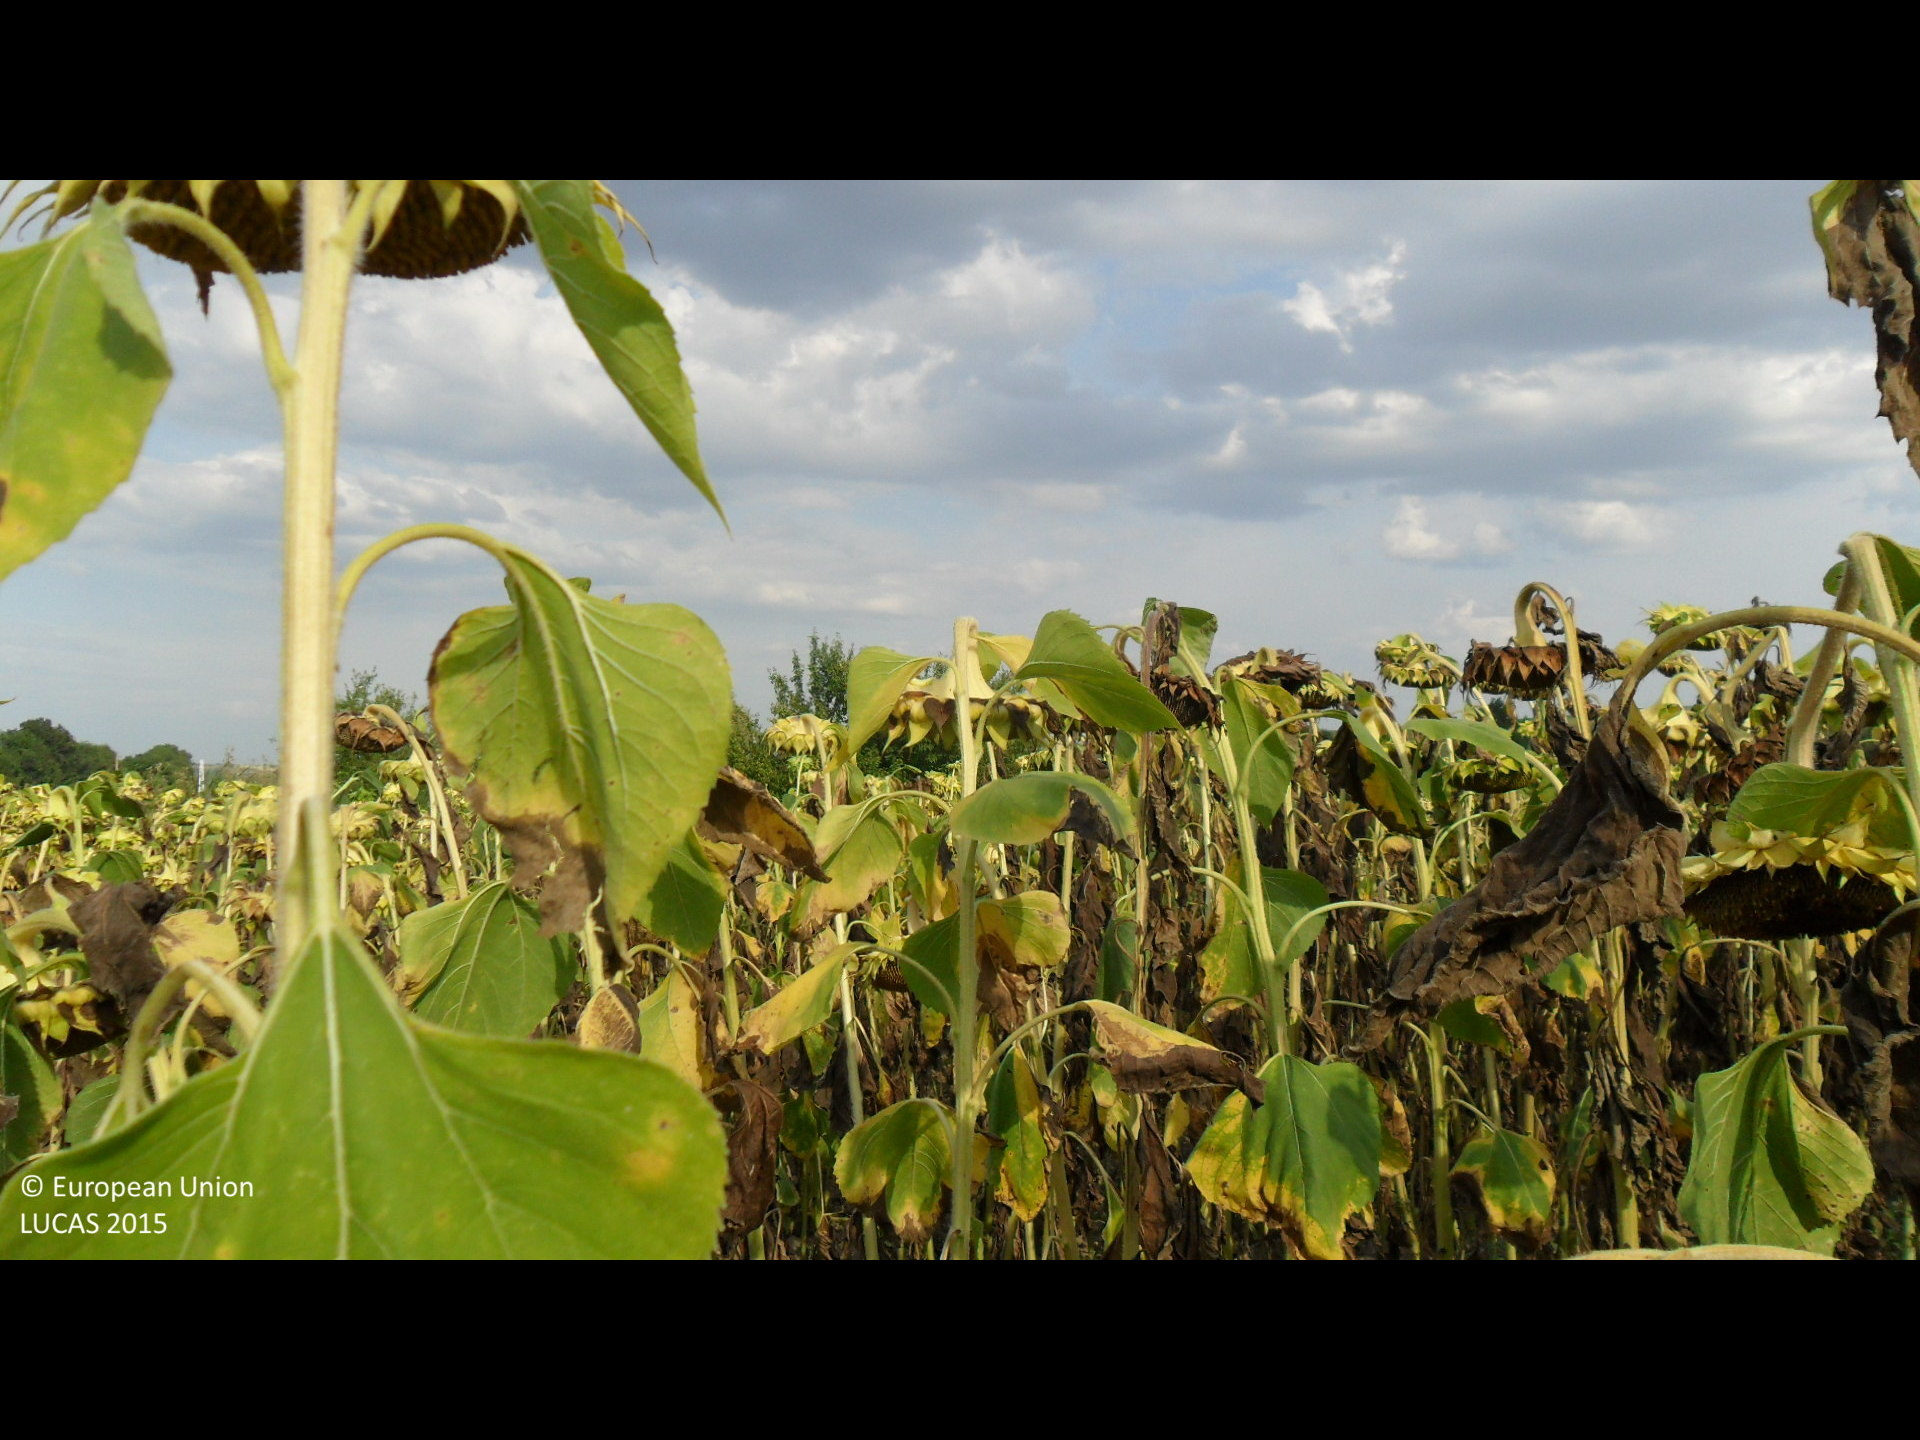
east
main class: Cropland
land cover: Sunflower
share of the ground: > 75 %
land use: Agriculture (excluding fallow land and kitchen gardens)
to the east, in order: Sunflower; Broadleaved woodland; Tracks; Grassland without tree/shrub cover; Fences; Grassland without tree/shrub cover; Tracks; Grassland without tree/shrub cover; Sunflower
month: August
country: BG
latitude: 43.3555
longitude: 26.1210
